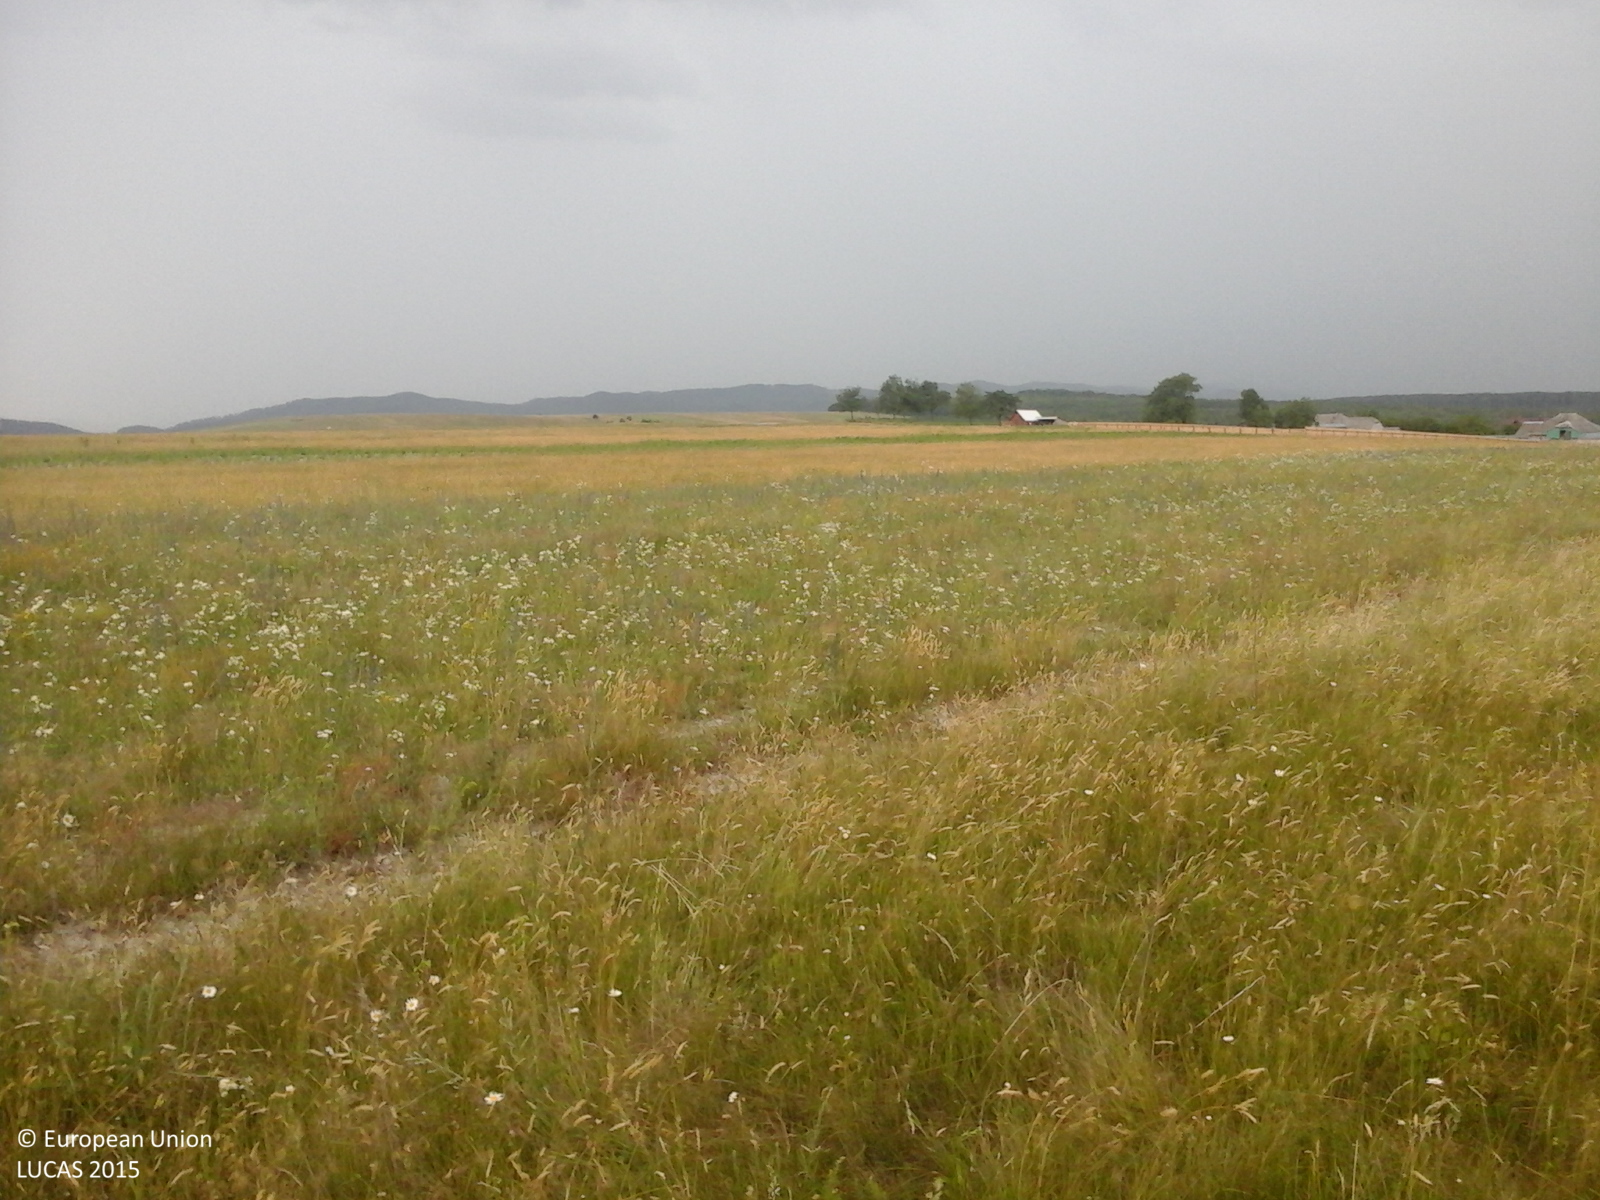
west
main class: Grassland
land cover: Grassland without tree/shrub cover
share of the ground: > 75 %
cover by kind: herbaceous plants 100 %
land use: Agriculture (excluding fallow land and kitchen gardens)
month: June
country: RO
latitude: 47.2627
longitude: 26.3793
